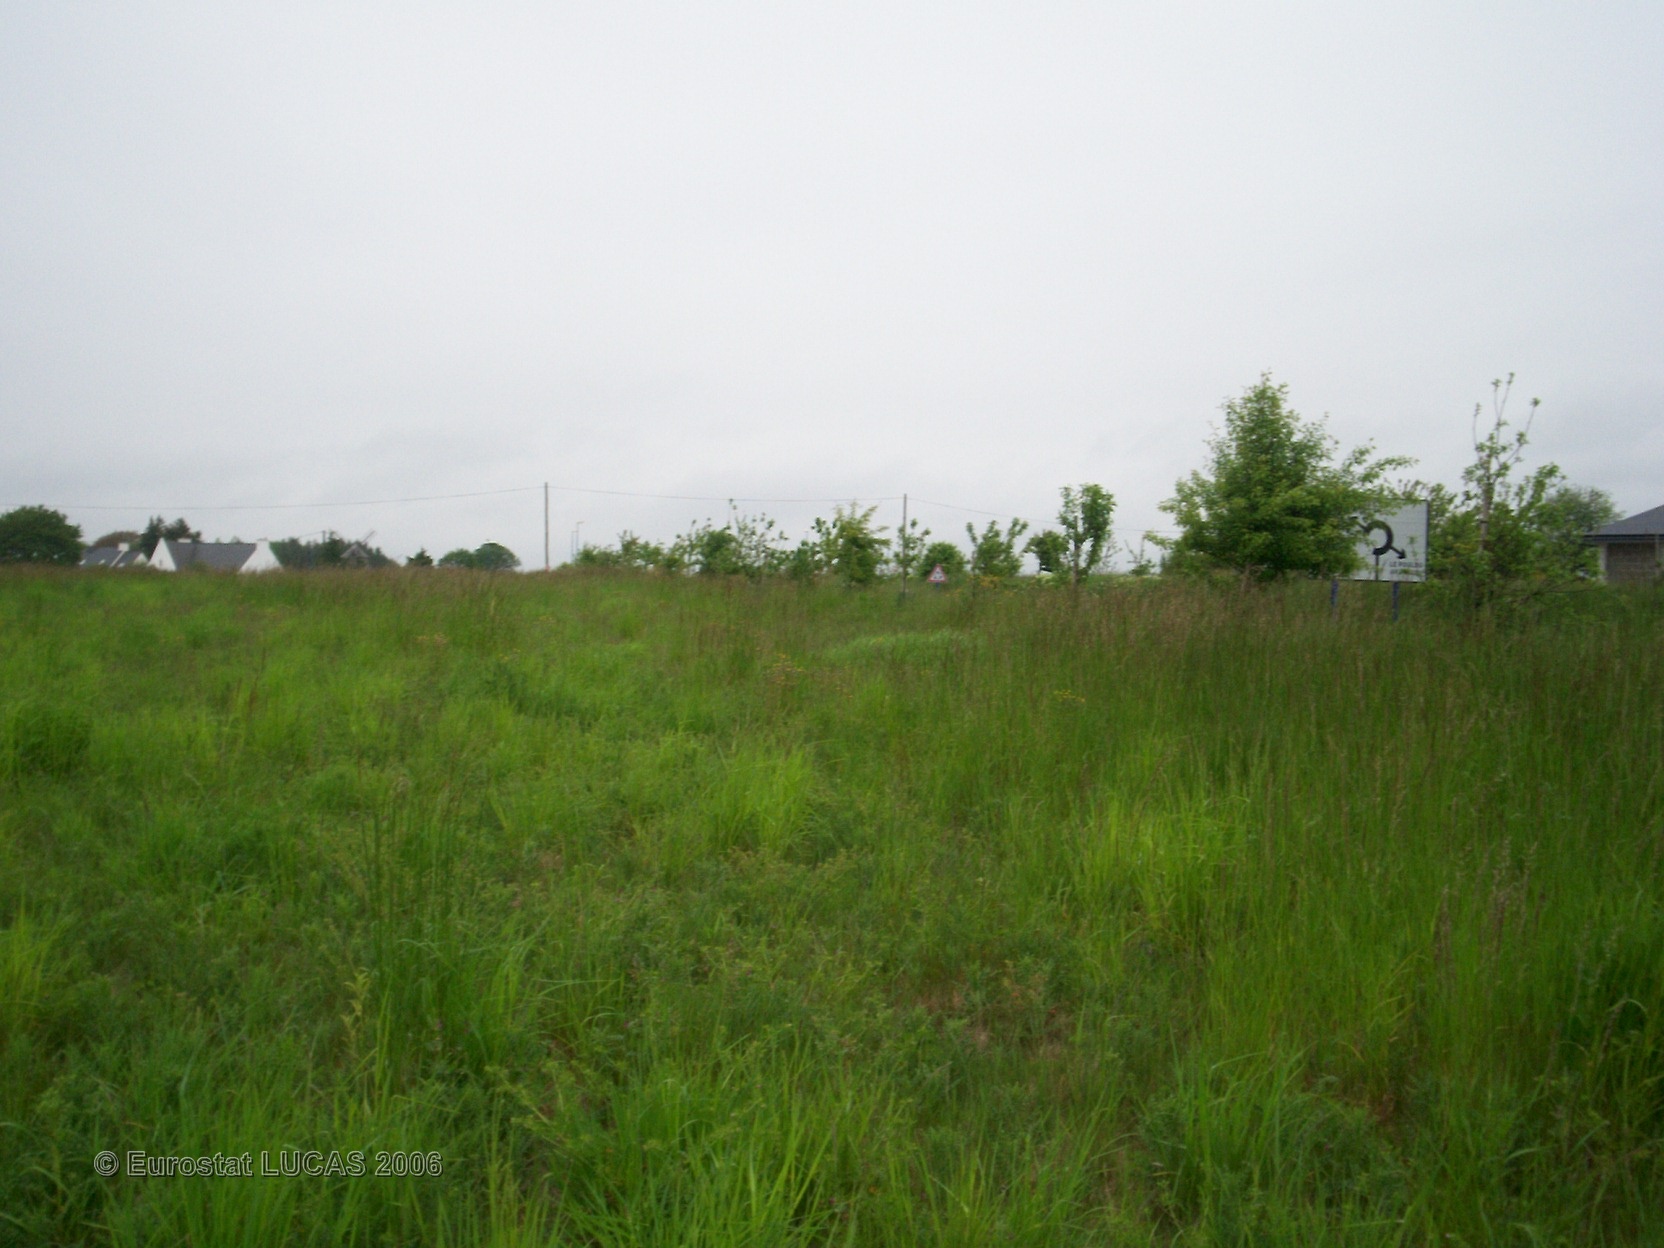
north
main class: Grassland
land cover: Grassland without tree/shrub cover
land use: Fallow land
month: May
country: FR
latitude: 47.7810
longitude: -3.5699
